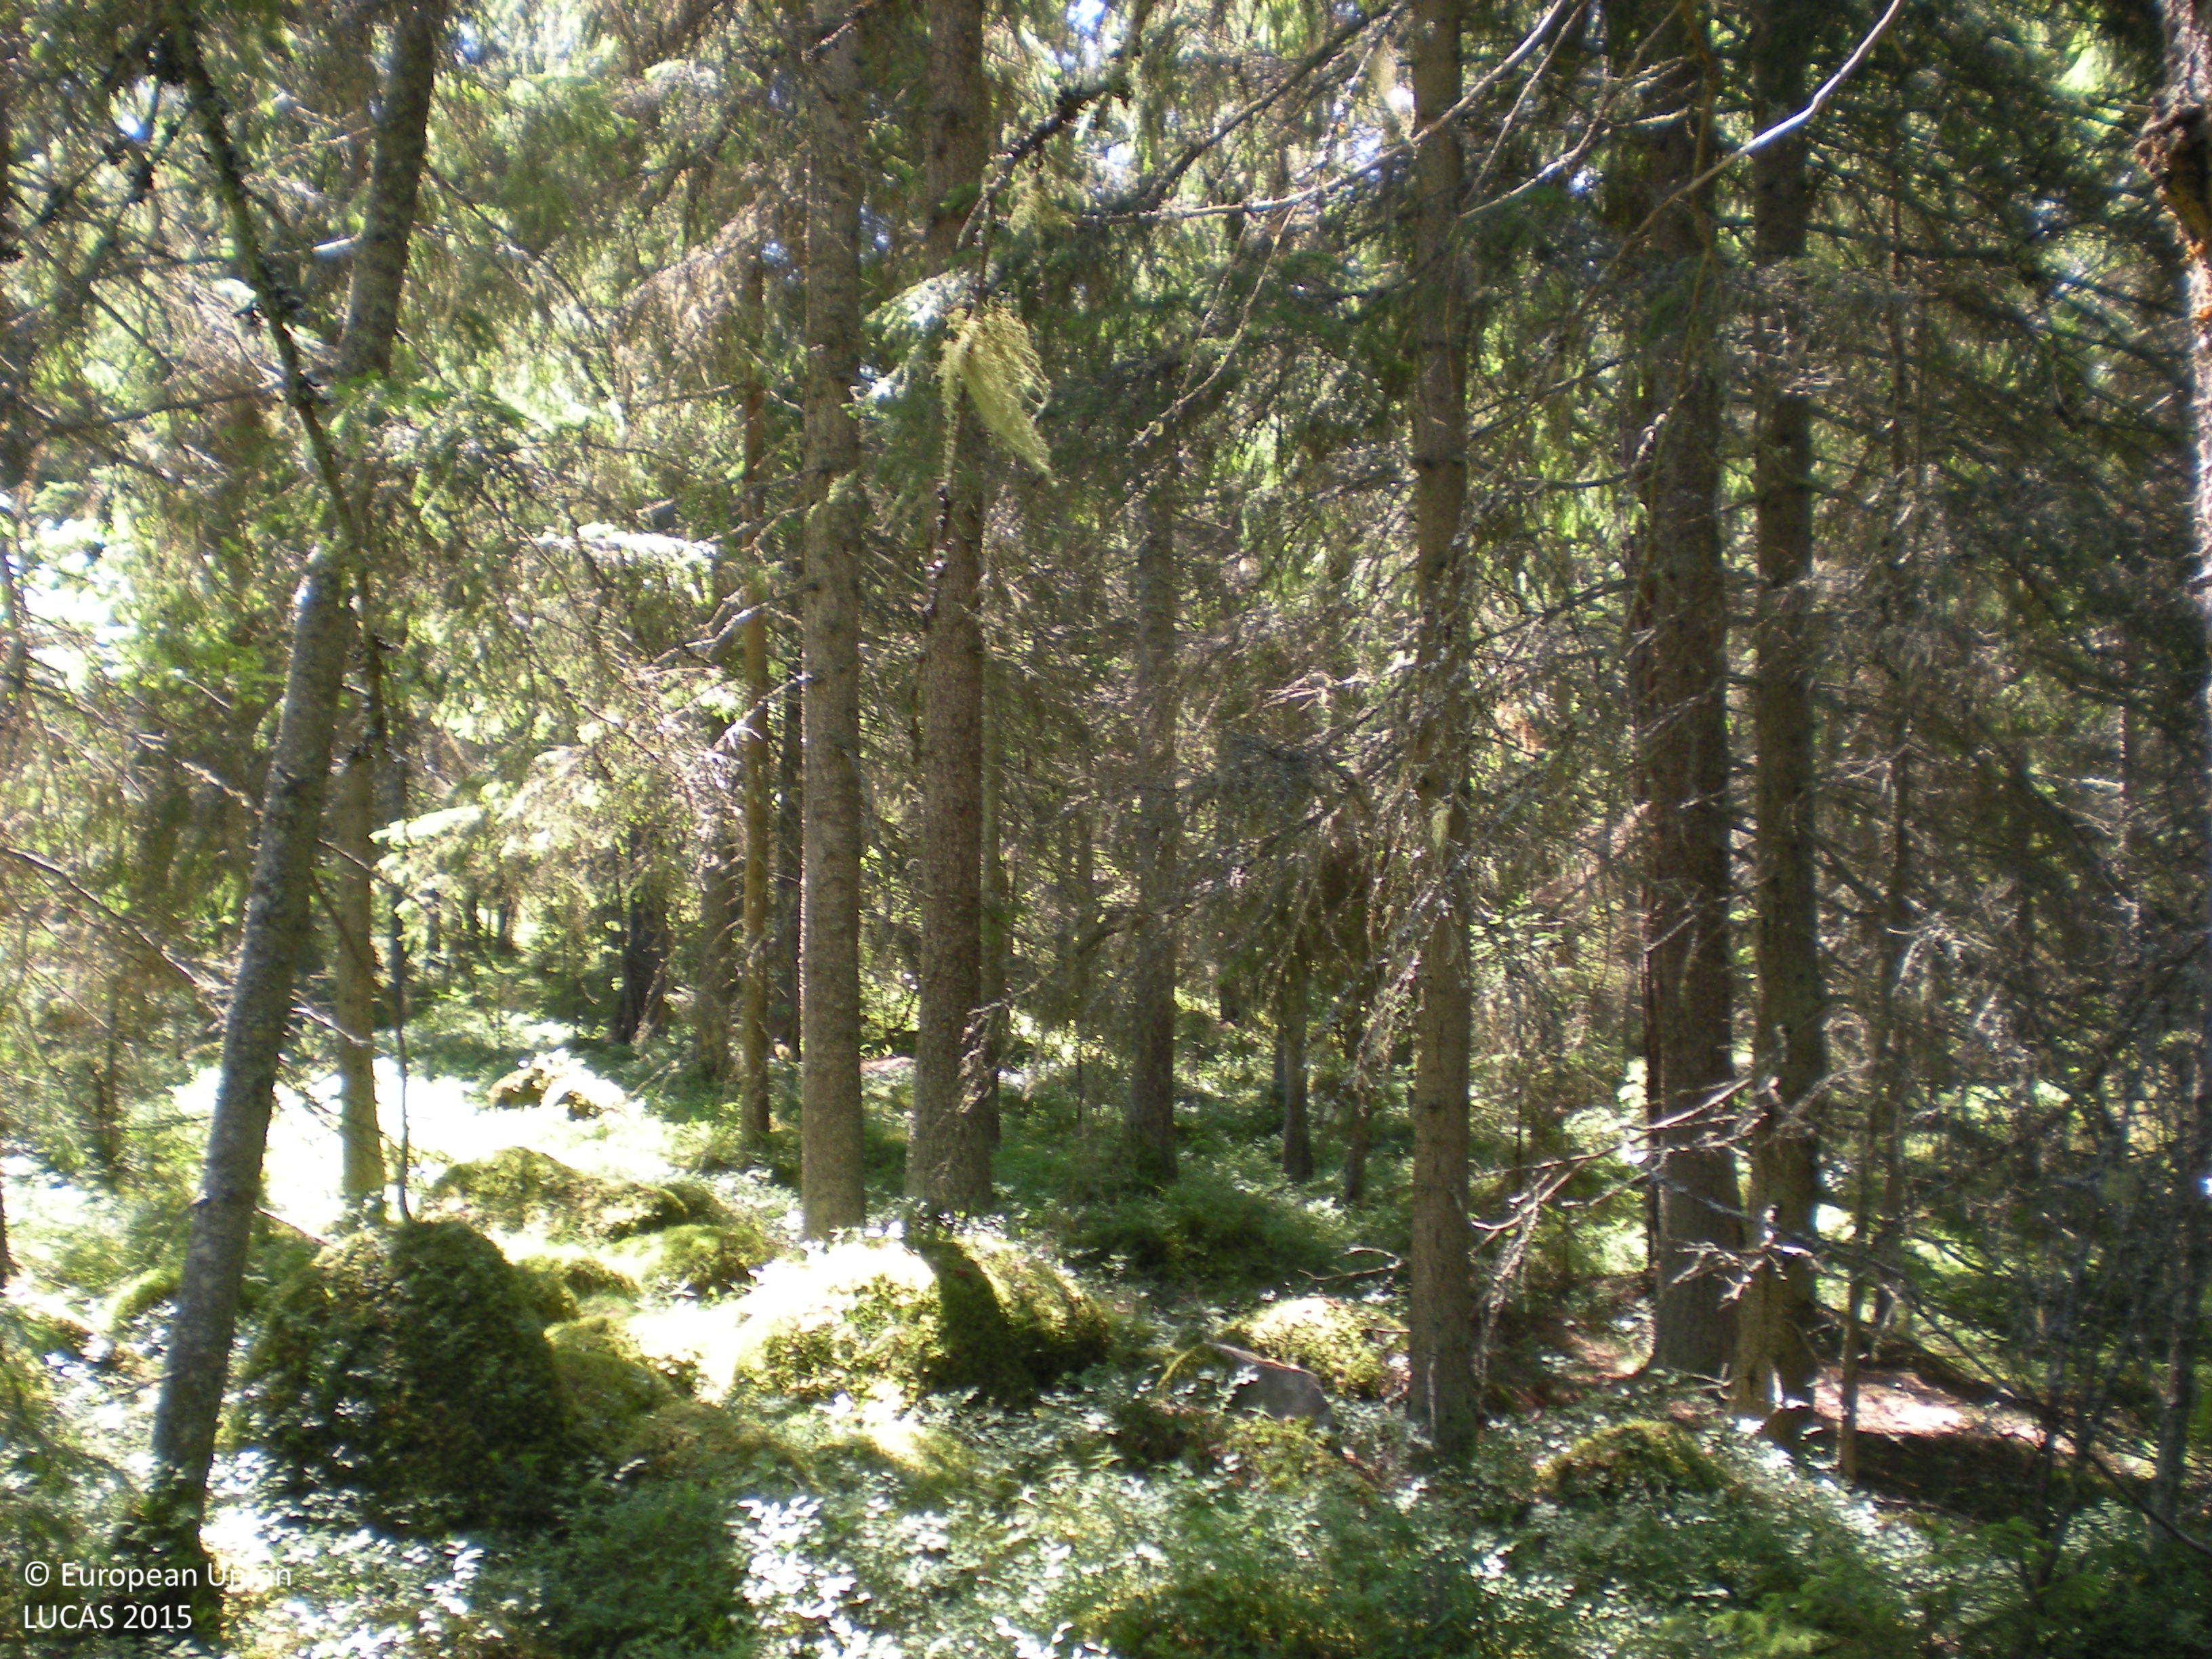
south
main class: Woodland
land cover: Spruce dominated coniferous woodland
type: boreal forest
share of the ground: > 75 %
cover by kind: coniferous forest trees 75 %, shrubs 10 %, lichens and mosses 10 %, broadleaved forest trees 5 %
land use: Amenities, museums, leisure
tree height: > 5 m
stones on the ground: > 50 %
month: June
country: SE
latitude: 60.4934
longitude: 18.0564
